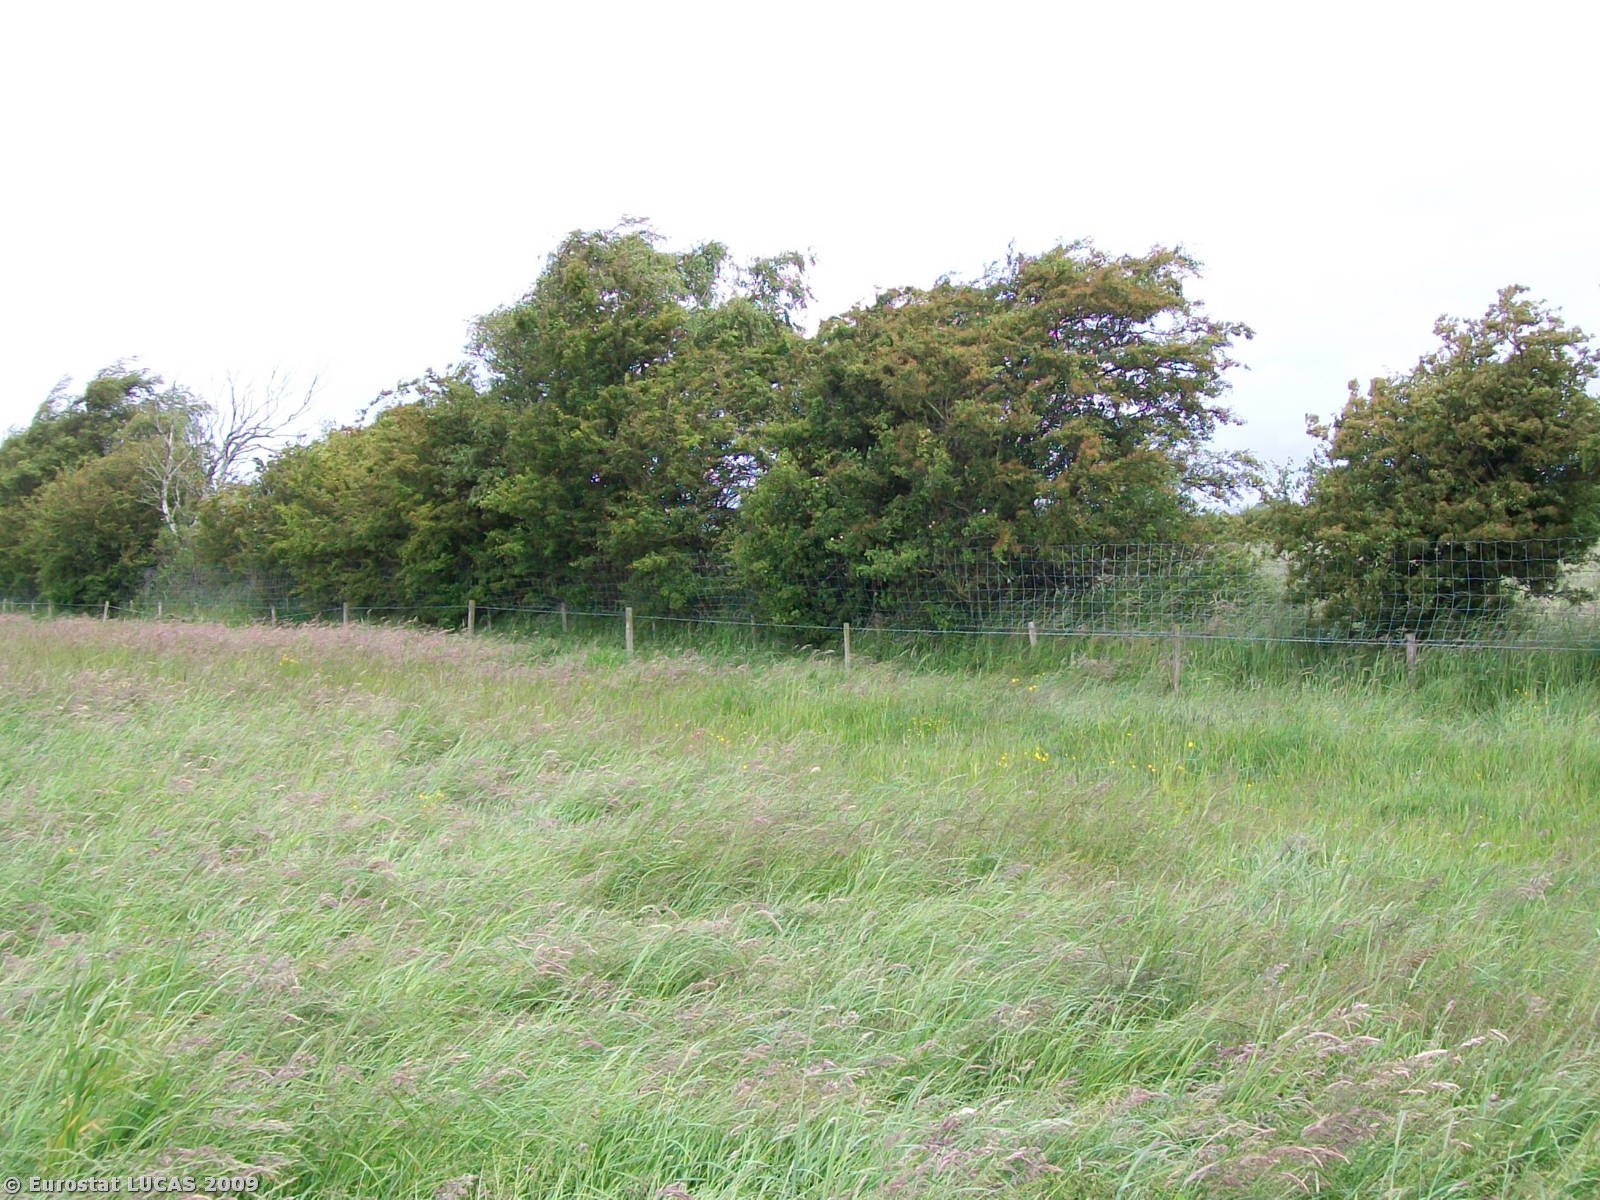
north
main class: Grassland
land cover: Grassland without tree/shrub cover
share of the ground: > 75 %
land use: Agriculture (excluding fallow land and kitchen gardens)
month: June
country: GB
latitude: 54.8767
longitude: -3.2456
